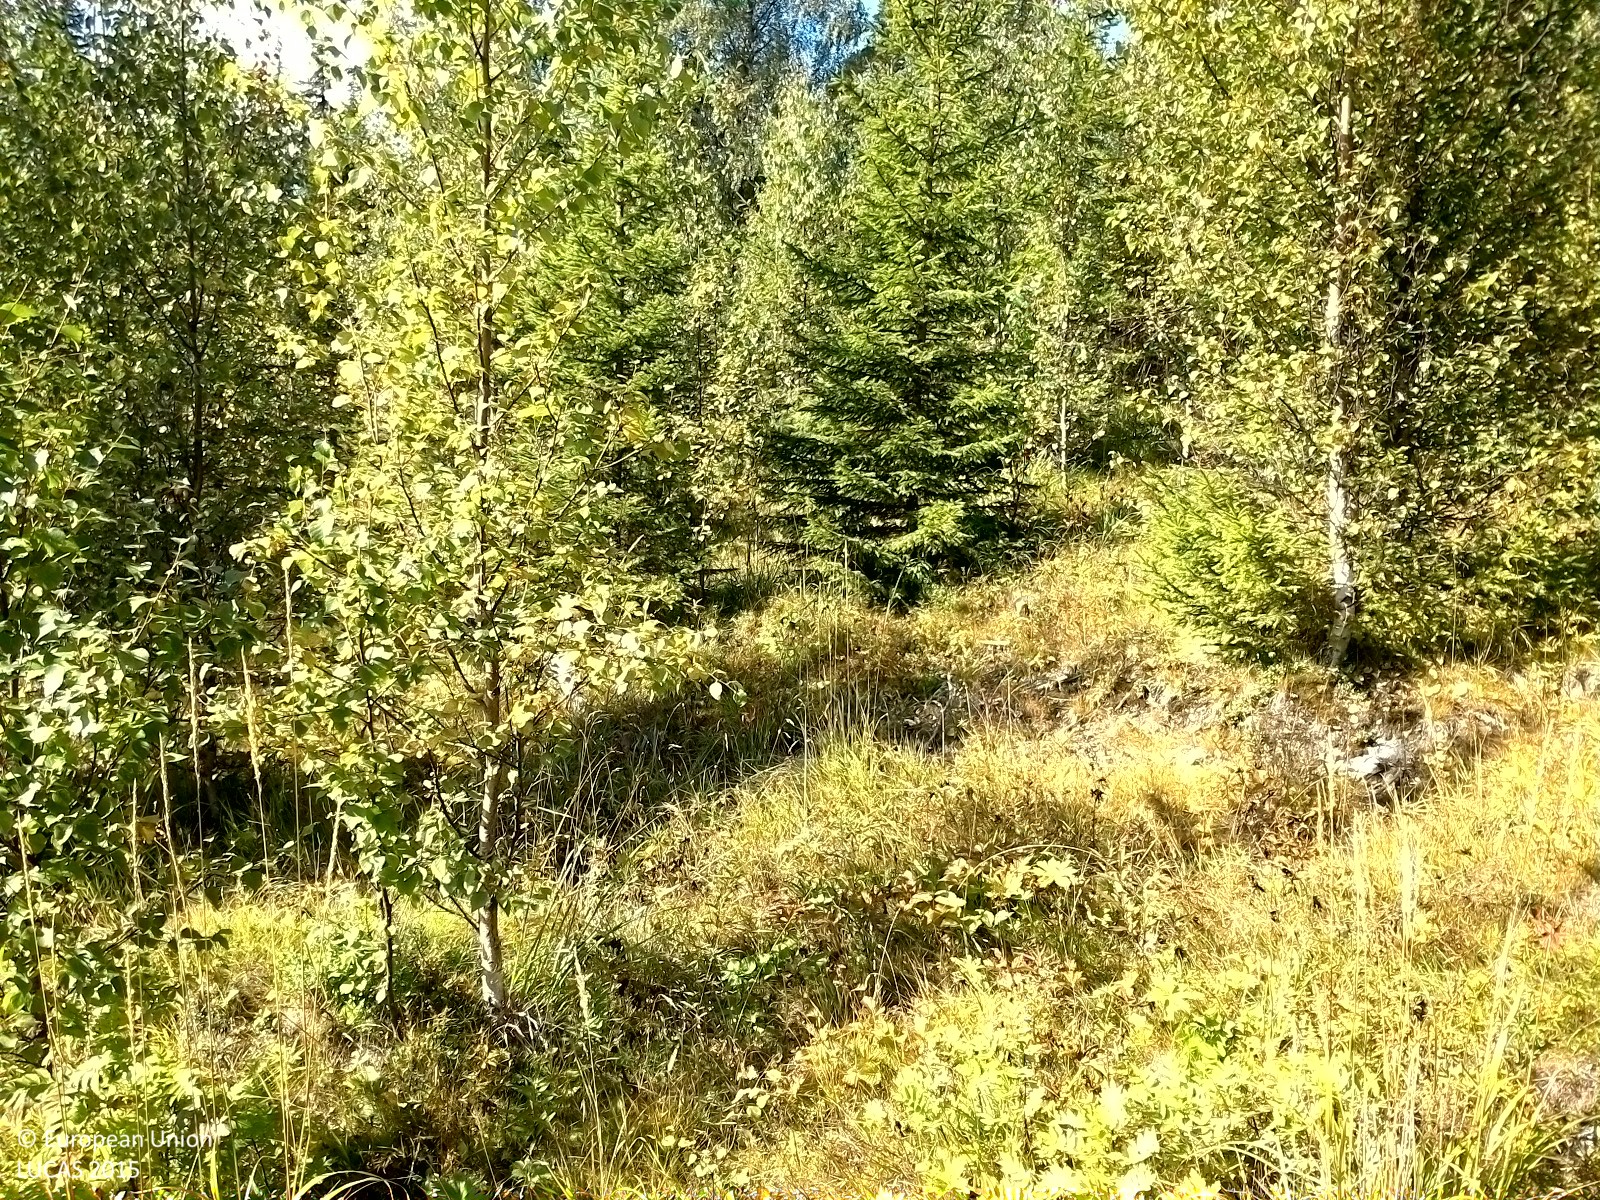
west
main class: Woodland
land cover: Spruce dominated mixed woodland
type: boreal forest
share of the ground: 25 - 50 %
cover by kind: herbaceous plants 60 %, coniferous forest trees 20 %, broadleaved forest trees 20 %
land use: Forestry
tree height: < 5 m
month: September
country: SE
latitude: 62.5872
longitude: 16.3452
